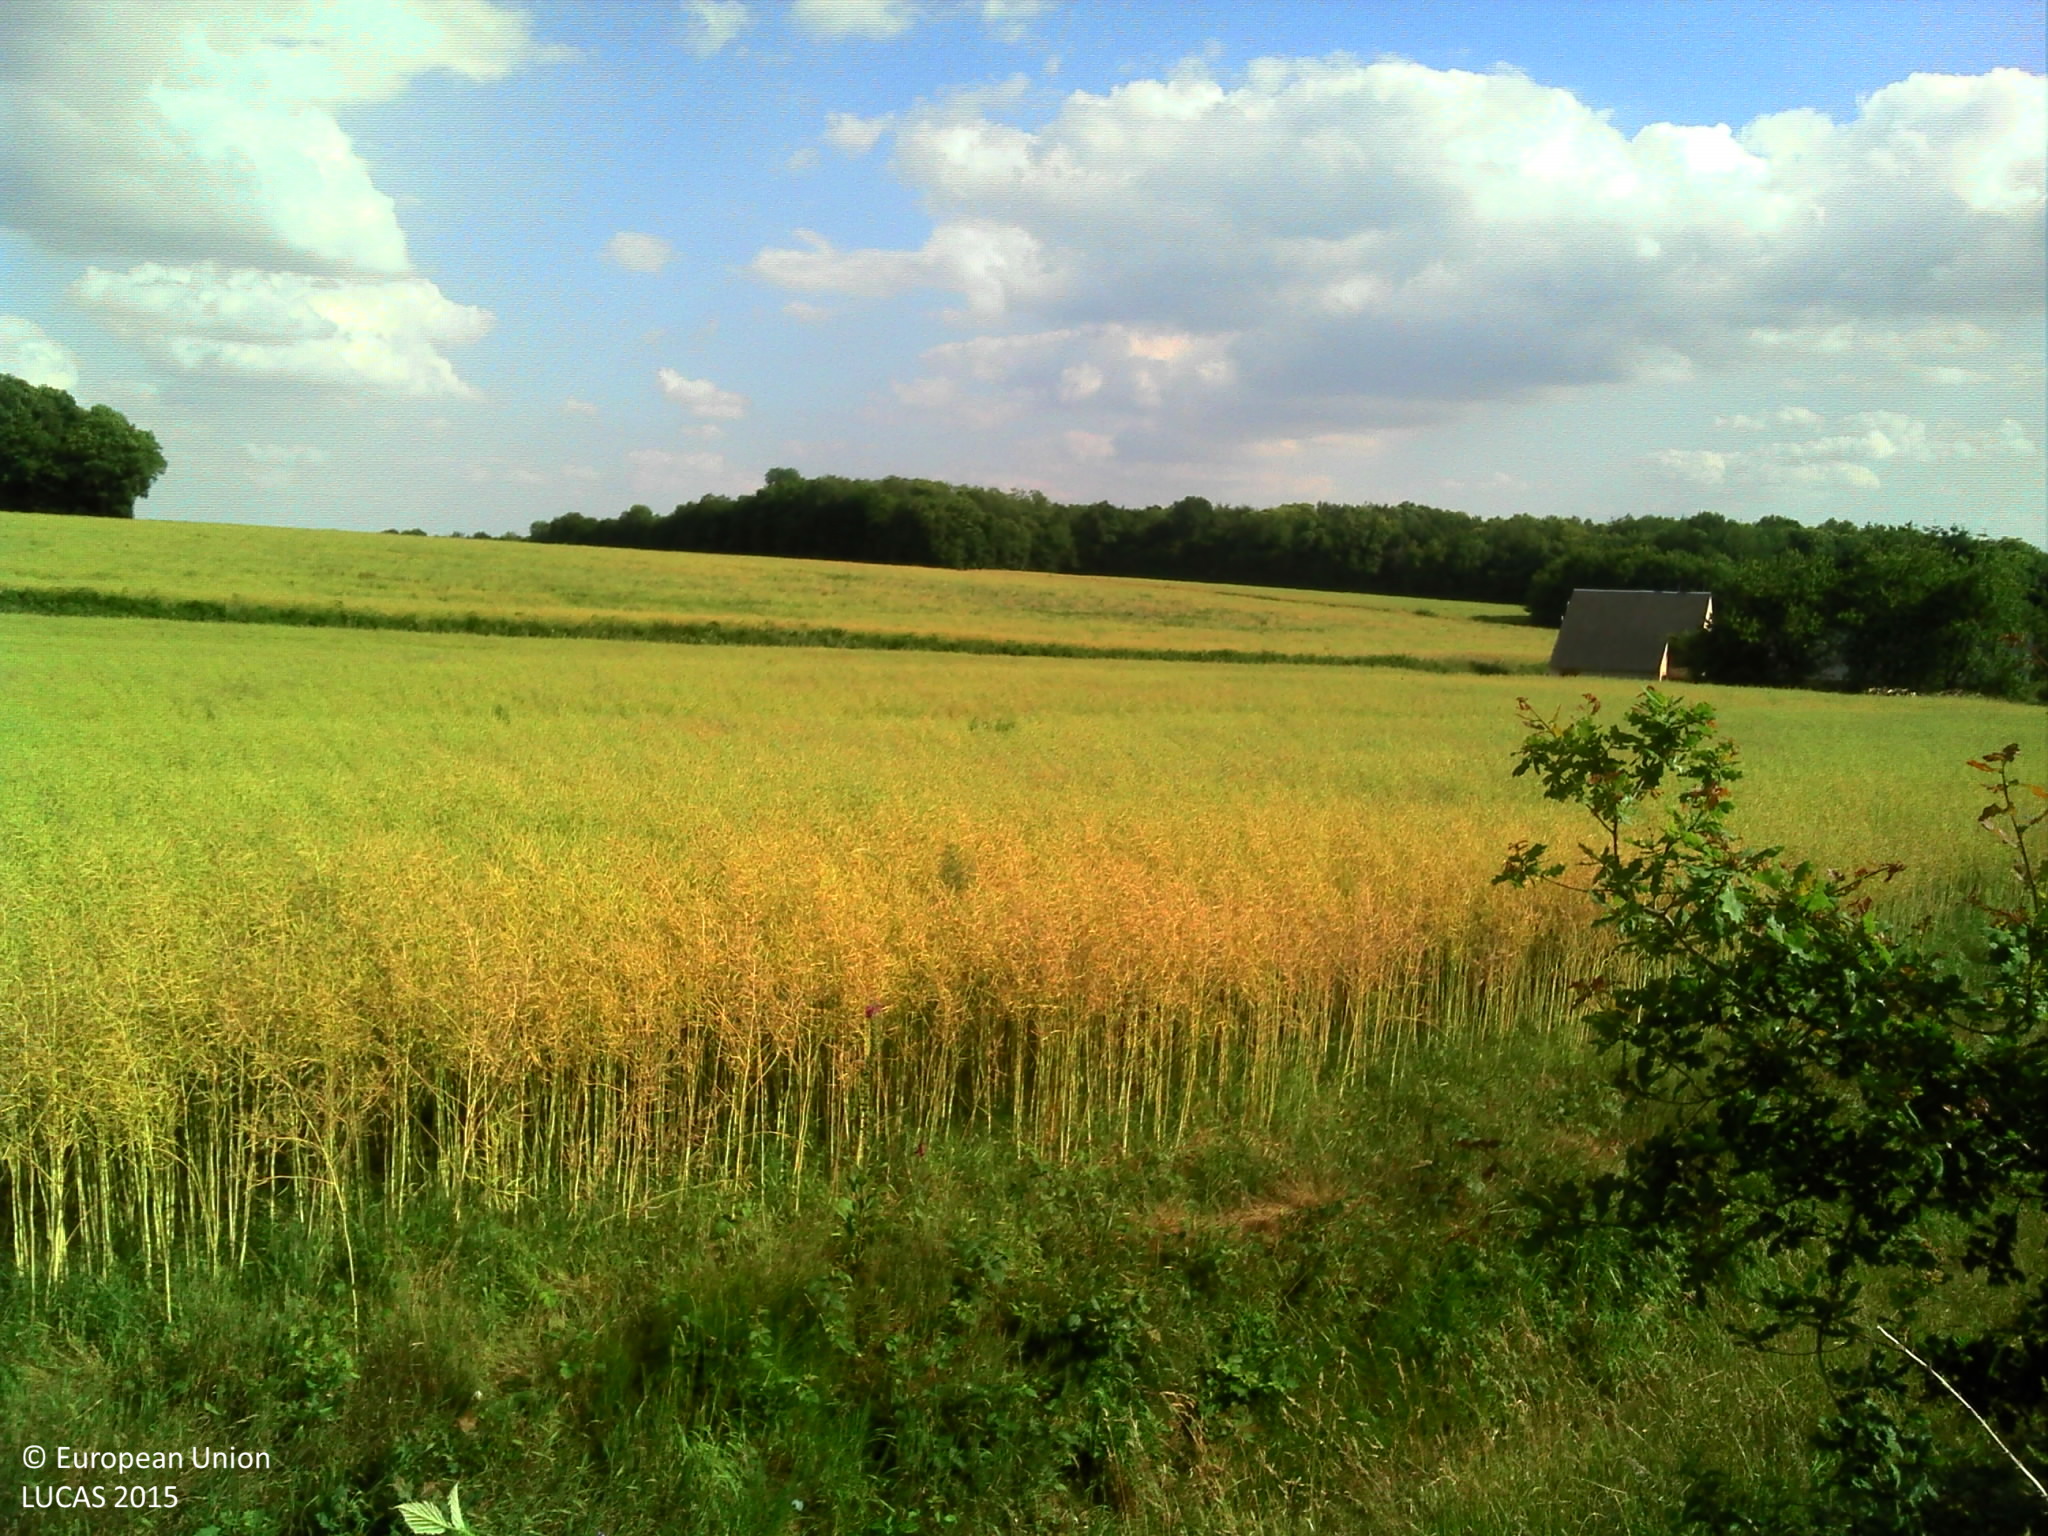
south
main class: Cropland
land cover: Rape and turnip rape
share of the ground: > 75 %
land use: Agriculture (excluding fallow land and kitchen gardens)
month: June
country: FR
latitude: 47.3597
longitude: 2.5916
